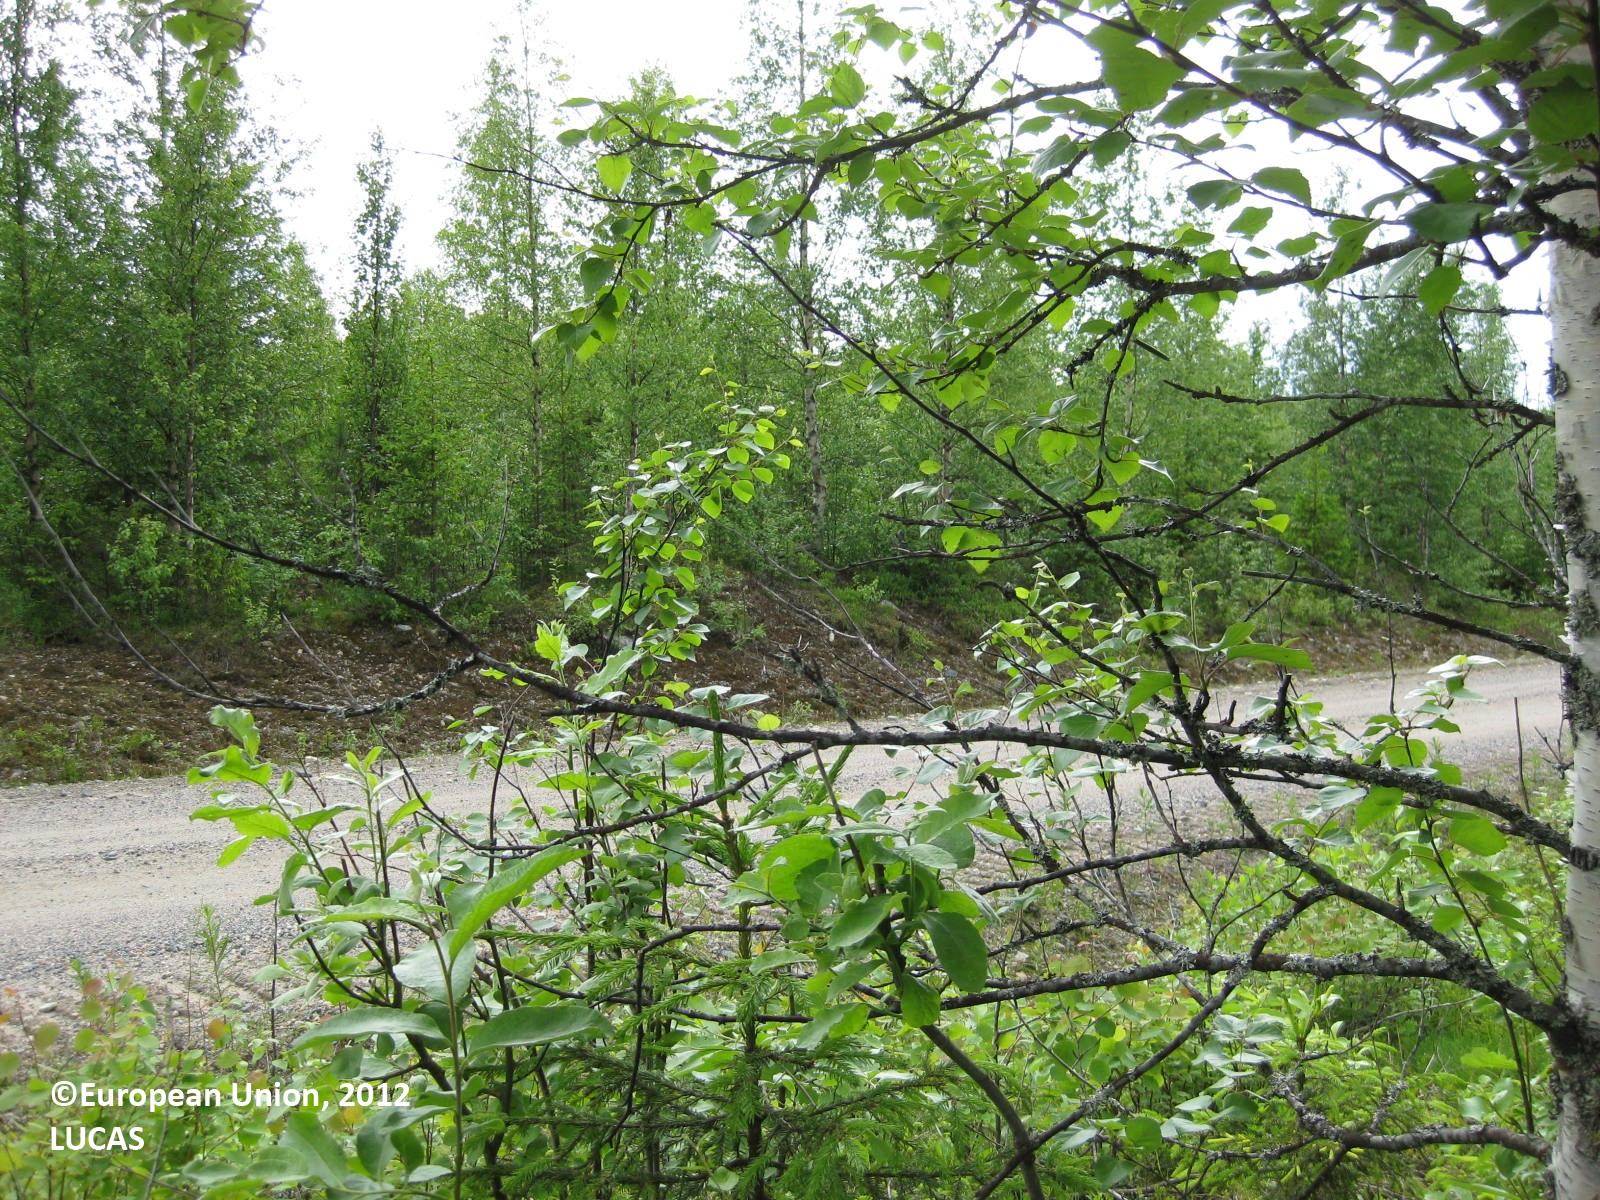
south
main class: Woodland
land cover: Spruce dominated mixed woodland
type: boreal forest
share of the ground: > 75 %
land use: Forestry
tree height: > 5 m
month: June
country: FI
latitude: 65.3003
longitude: 28.2803
